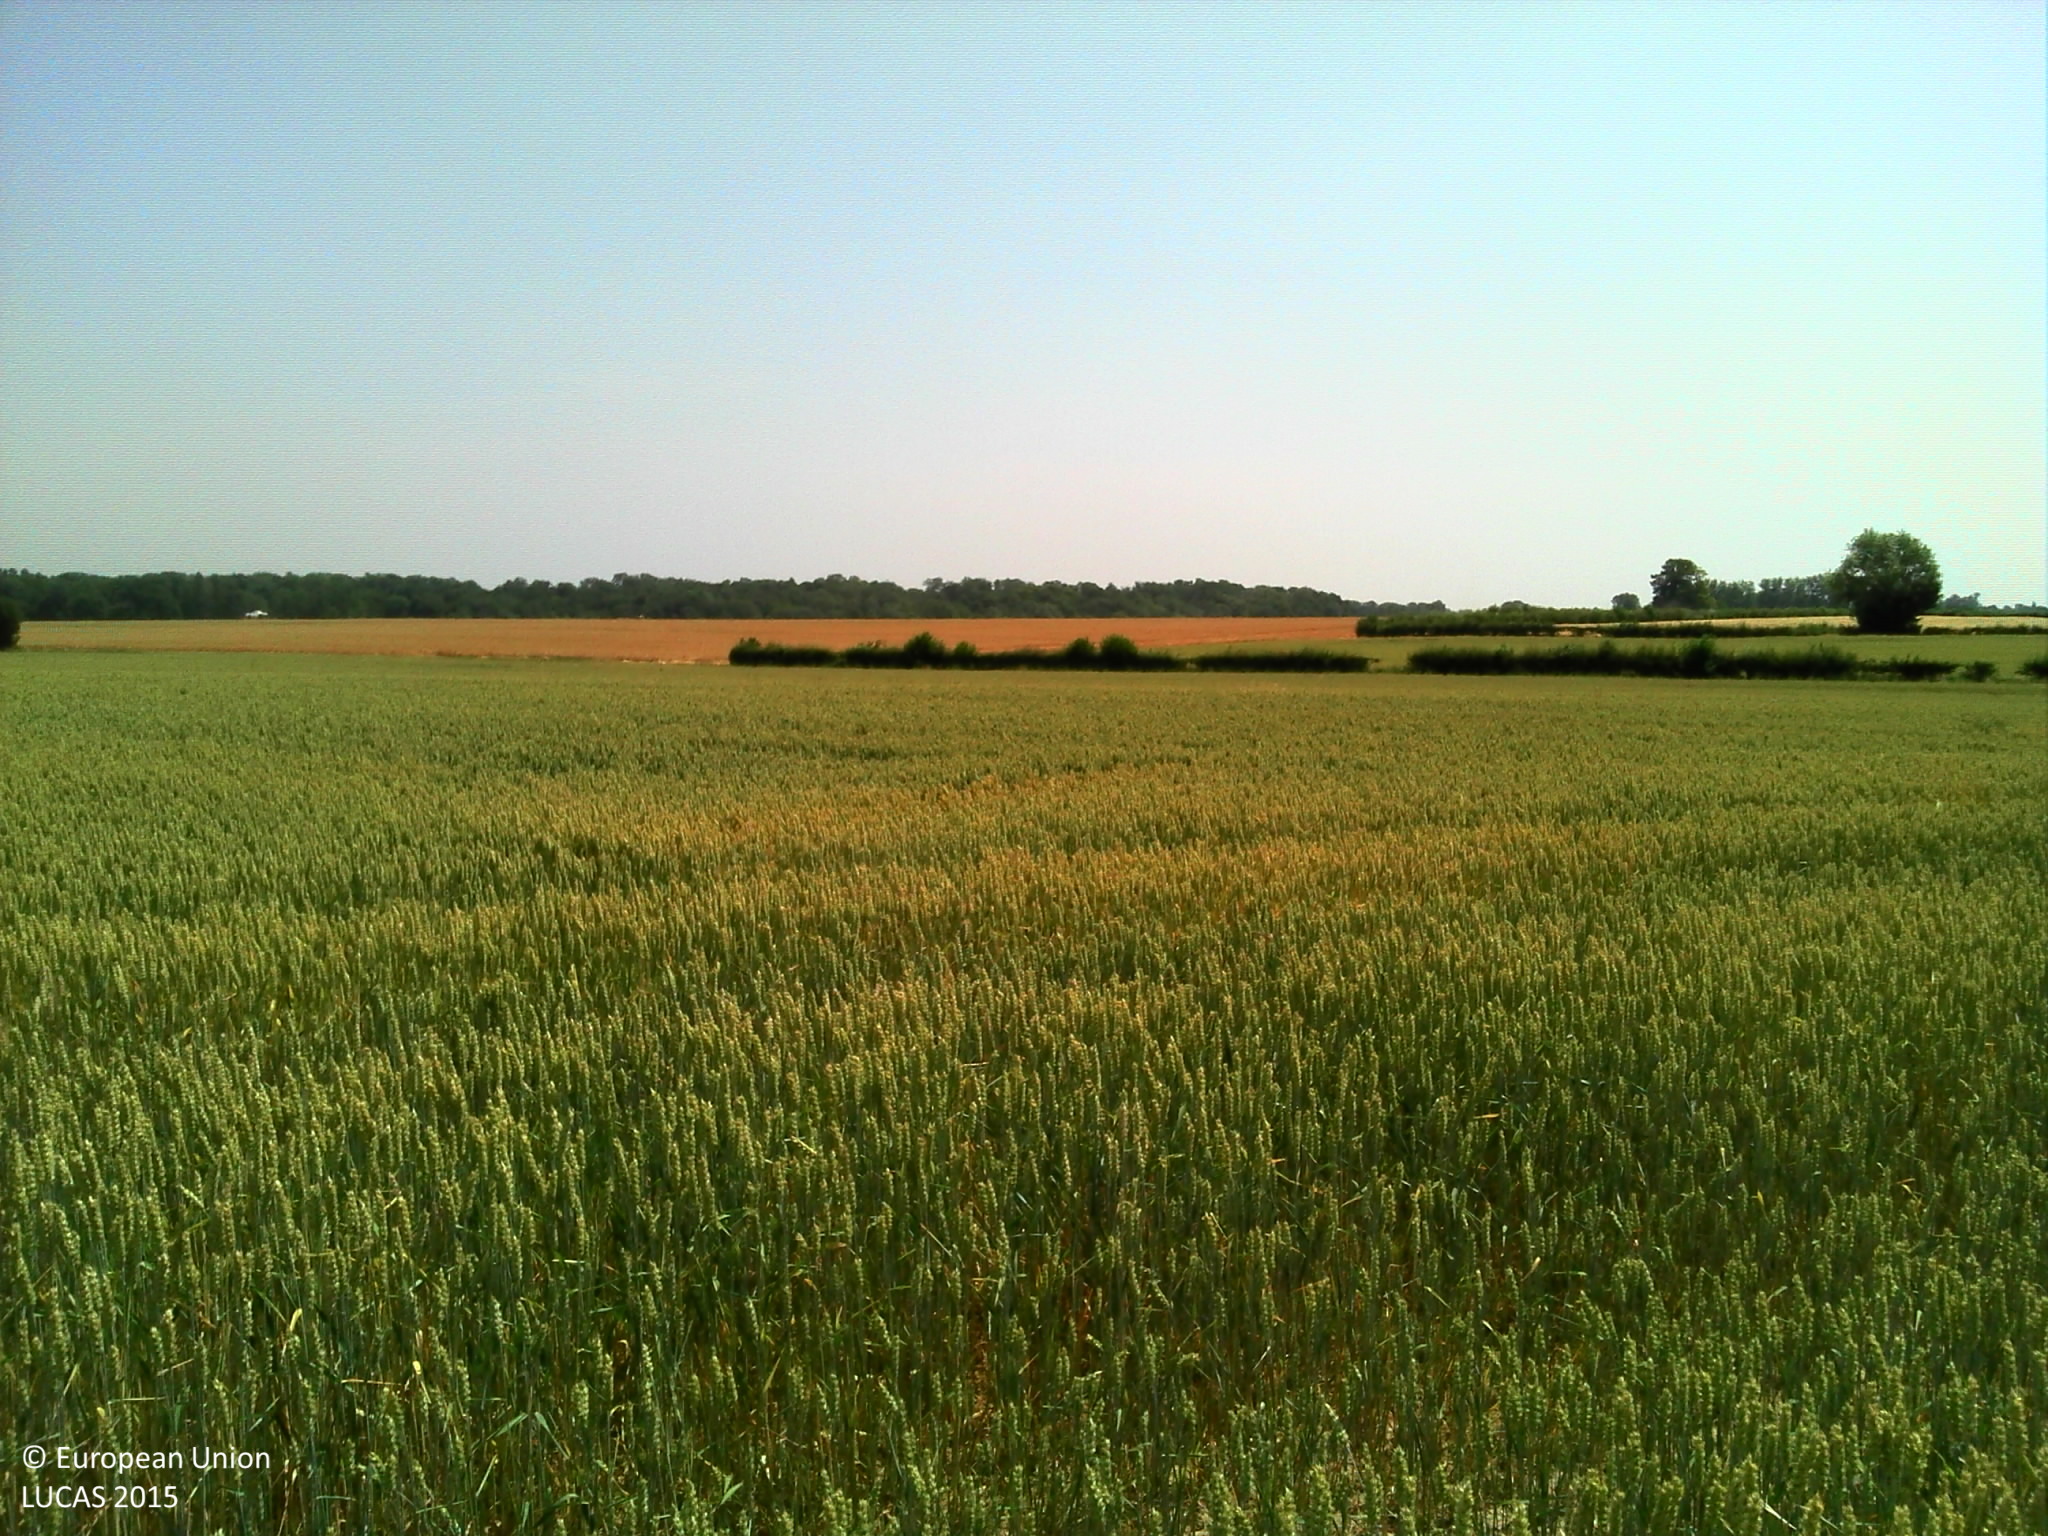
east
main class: Cropland
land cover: Common wheat
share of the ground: > 75 %
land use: Agriculture (excluding fallow land and kitchen gardens)
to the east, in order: Common wheat; Grass margins; Barley
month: July
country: FR
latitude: 49.7049
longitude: 1.7606
